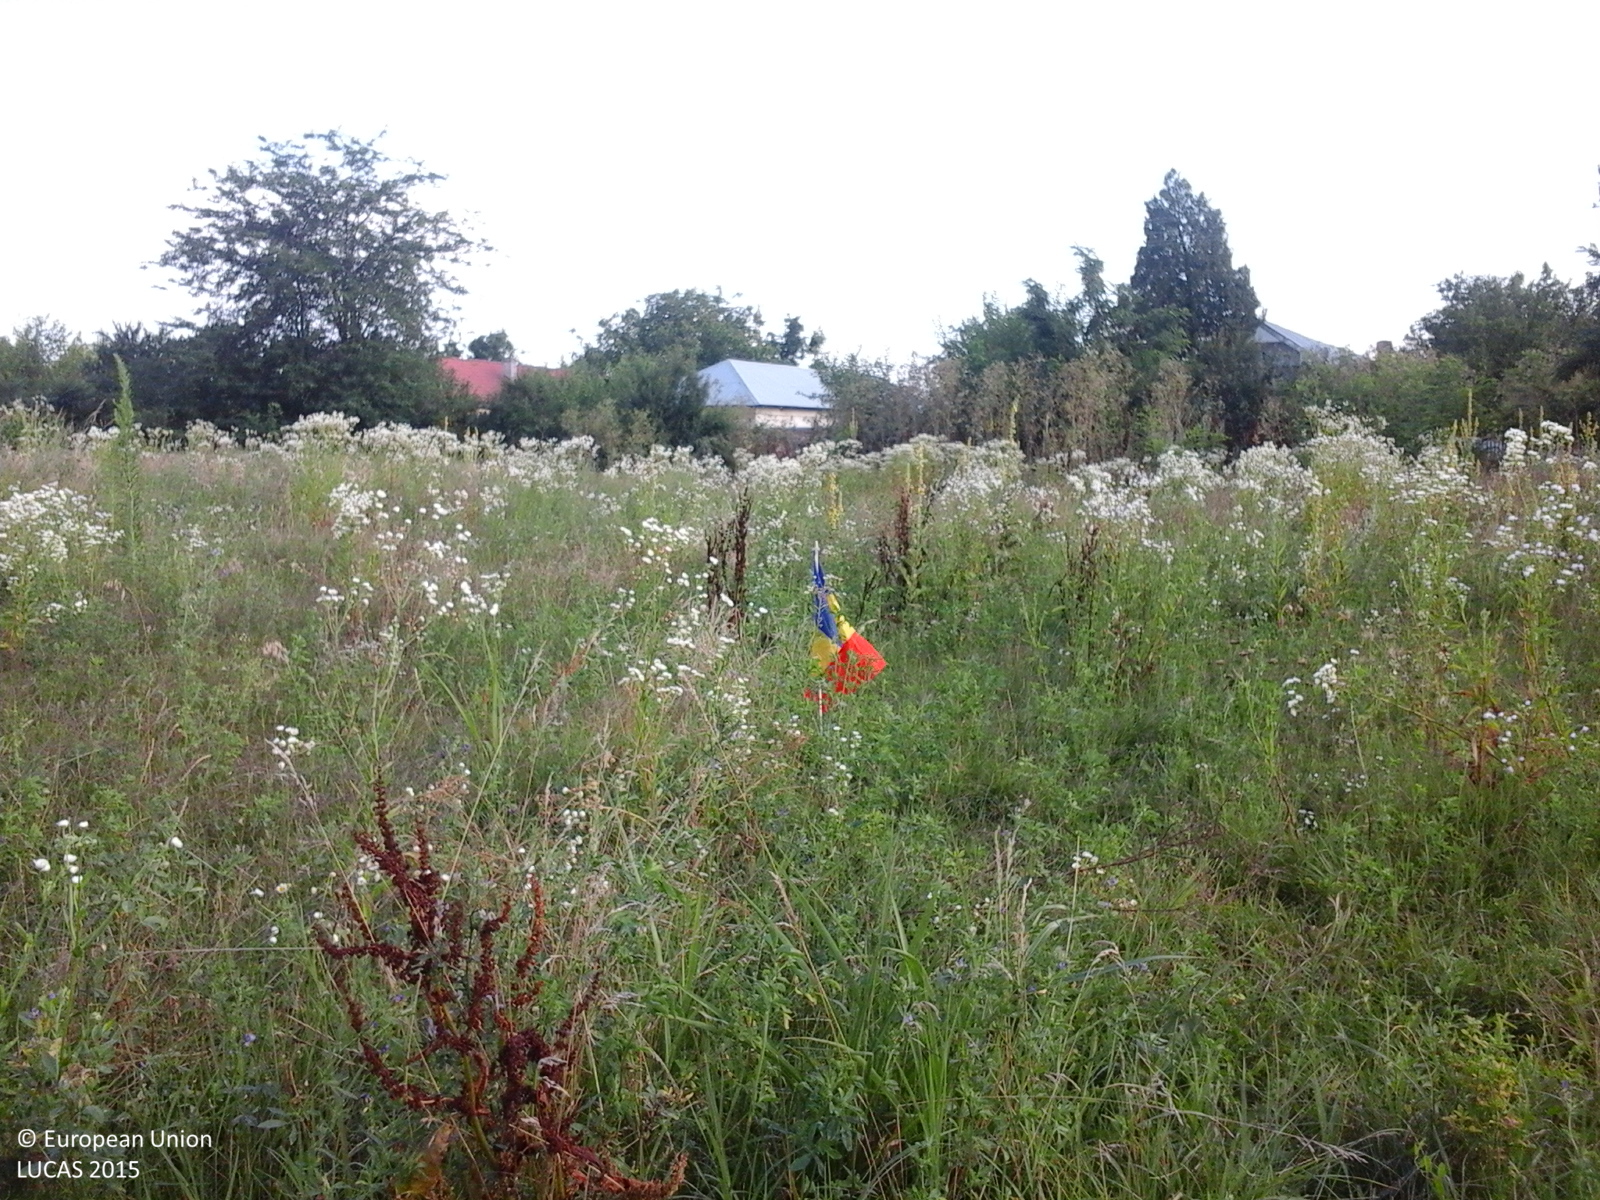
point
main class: Grassland
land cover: Spontaneously vegetated surfaces
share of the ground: > 75 %
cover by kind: herbaceous plants 100 %
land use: Agriculture (excluding fallow land and kitchen gardens)
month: July
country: RO
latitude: 44.1621
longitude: 24.4095
